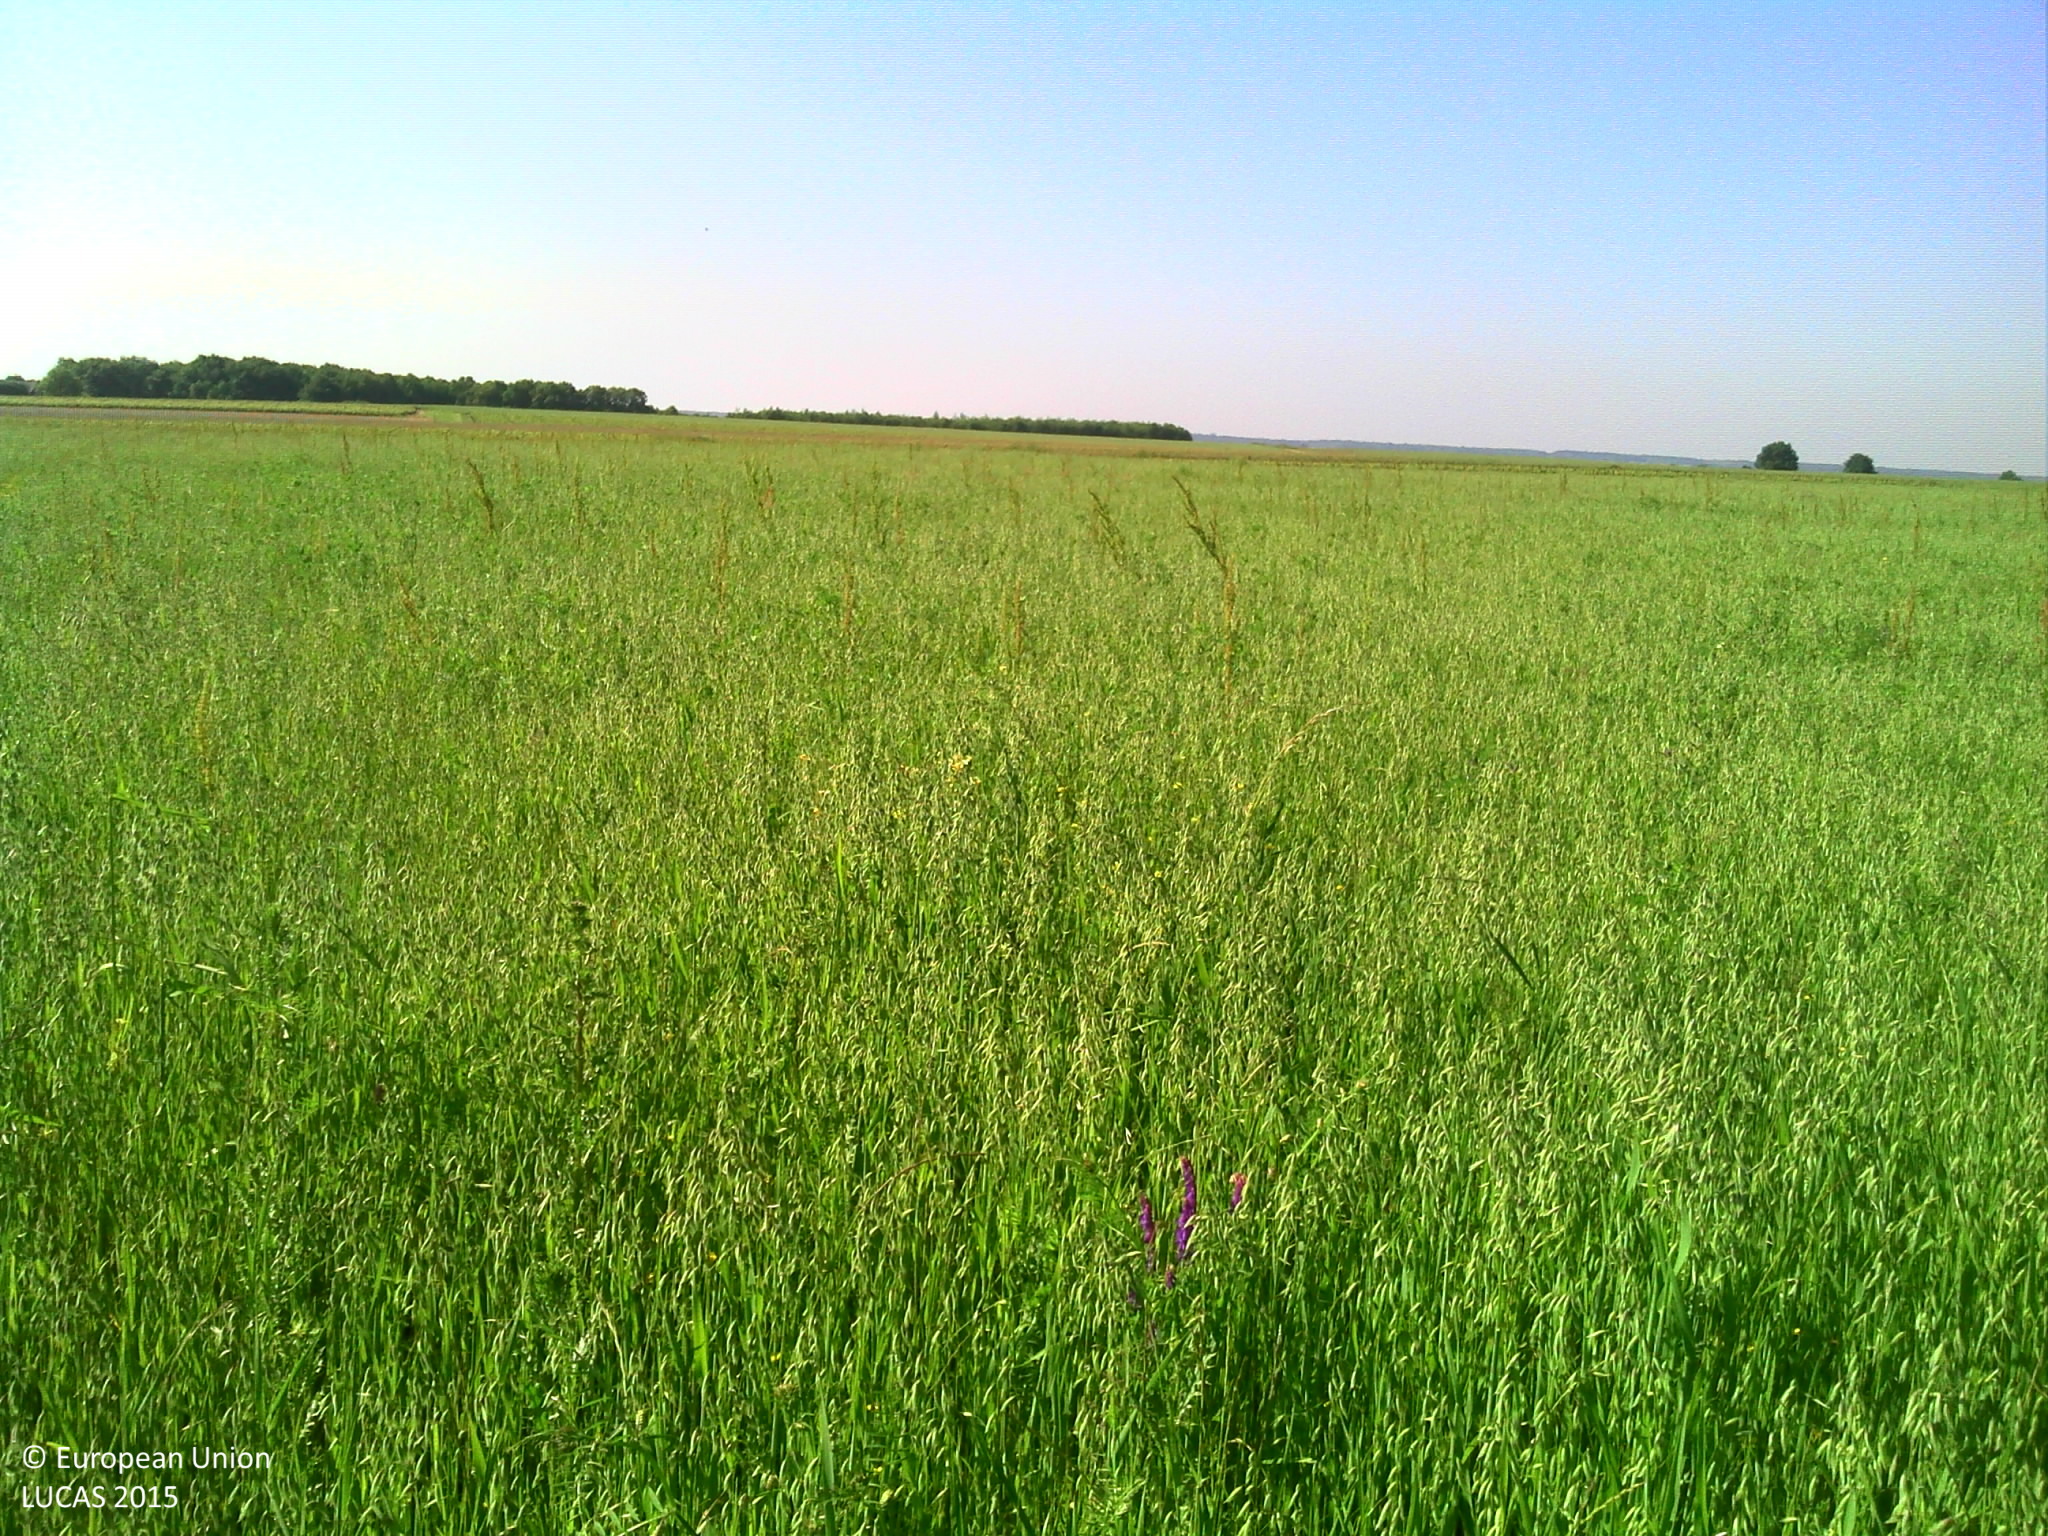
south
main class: Cropland
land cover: Mixed cereals for fodder
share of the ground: > 75 %
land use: Agriculture (excluding fallow land and kitchen gardens)
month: May
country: FR
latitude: 47.4567
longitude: 1.0028
